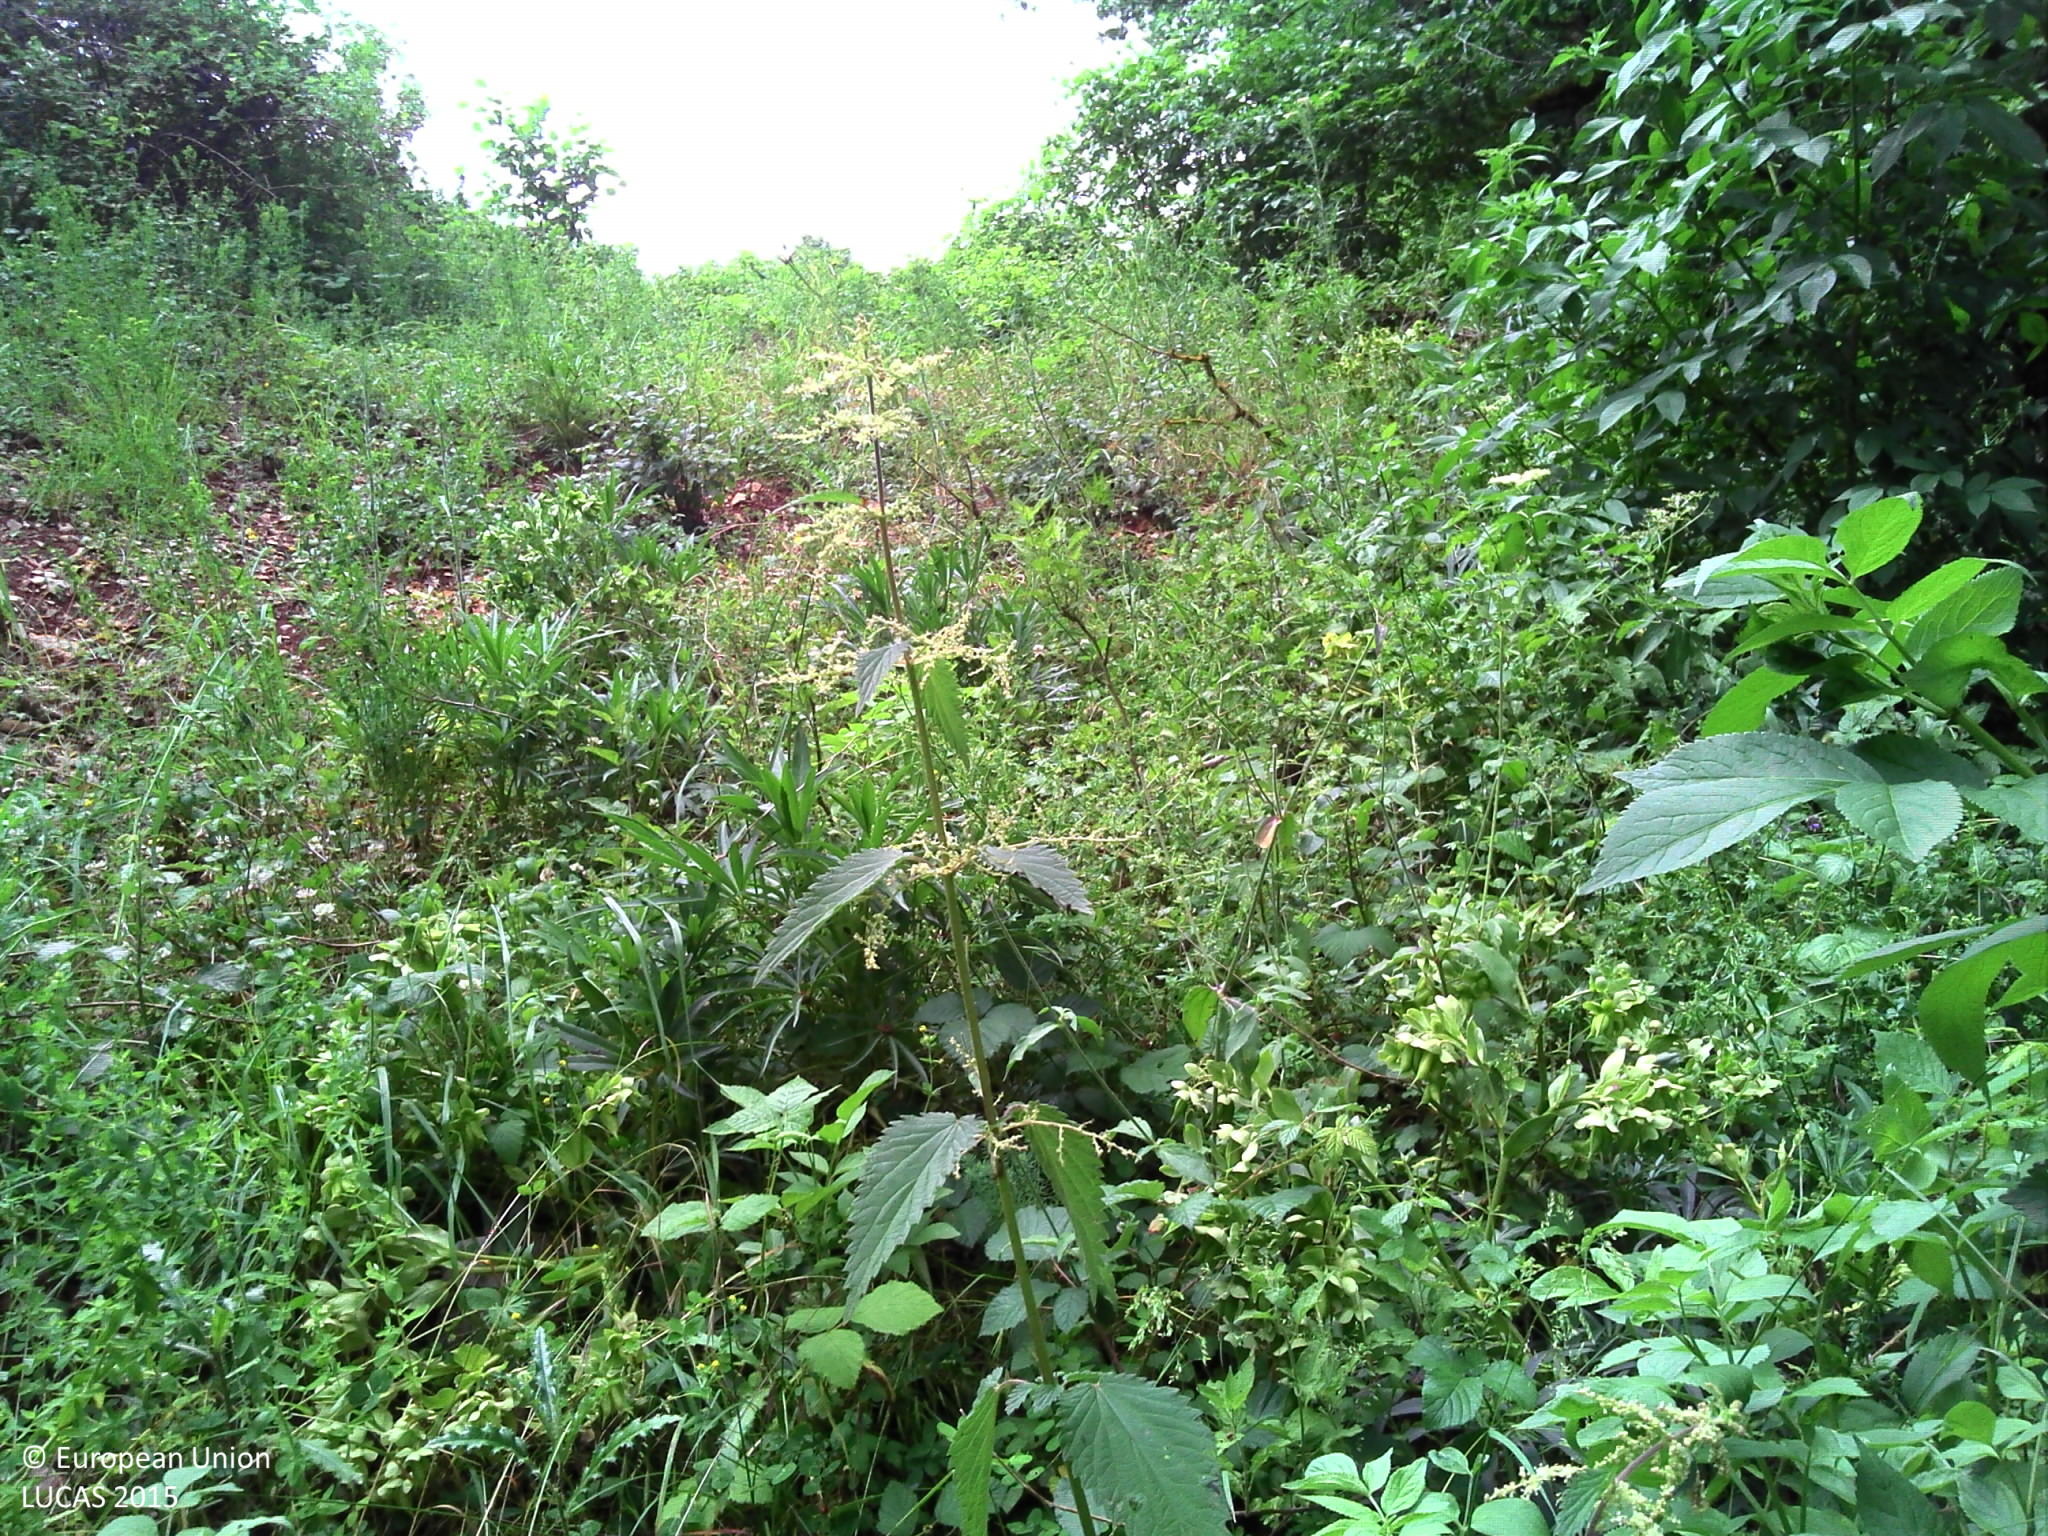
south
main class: Woodland
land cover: Broadleaved woodland
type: acidophilous oak and oak-birch forest
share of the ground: > 75 %
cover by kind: broadleaved forest trees 90 %, lichens and mosses 10 %
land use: Semi-natural and natural areas not in use
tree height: > 5 m
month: June
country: FR
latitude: 44.2820
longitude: 3.0758
